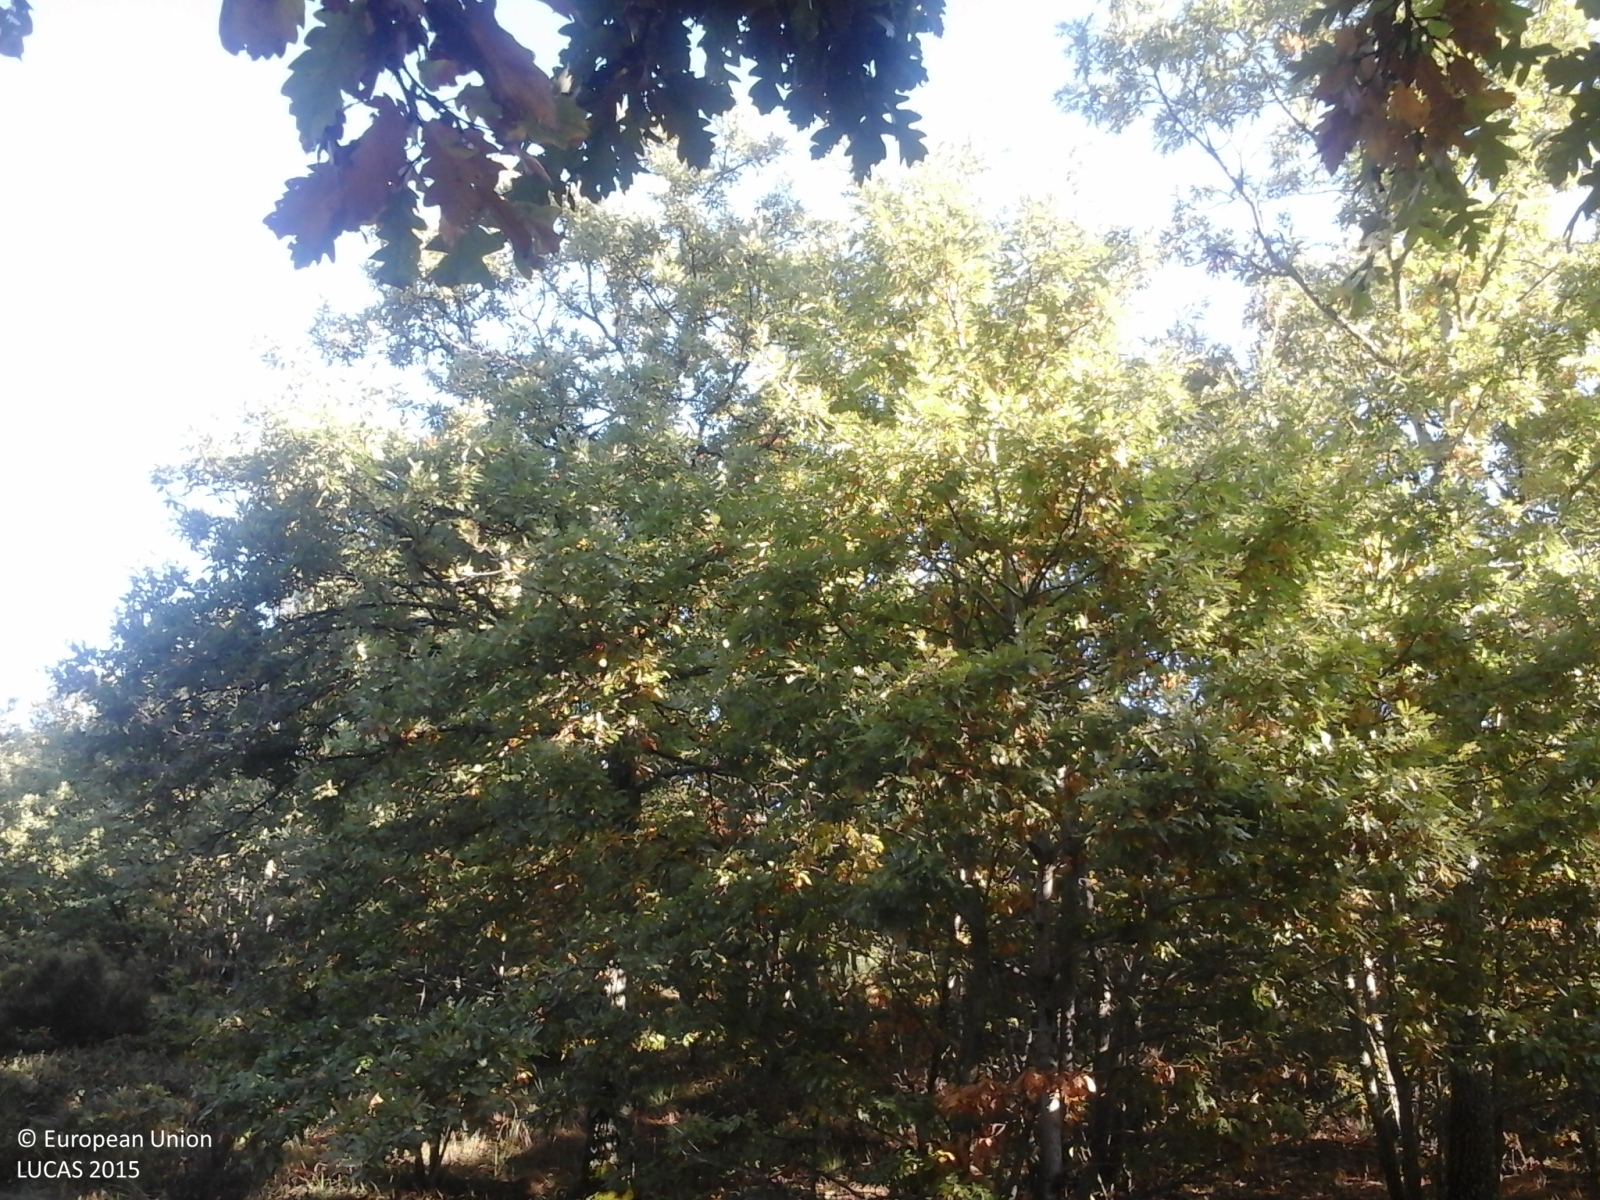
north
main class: Woodland
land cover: Broadleaved woodland
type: thermophilous deciduous forest
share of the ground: > 75 %
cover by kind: broadleaved forest trees 90 %, shrubs 5 %, herbaceous plants 5 %
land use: Forestry
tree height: > 5 m
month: October
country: IT
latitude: 43.4273
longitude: 12.0819
